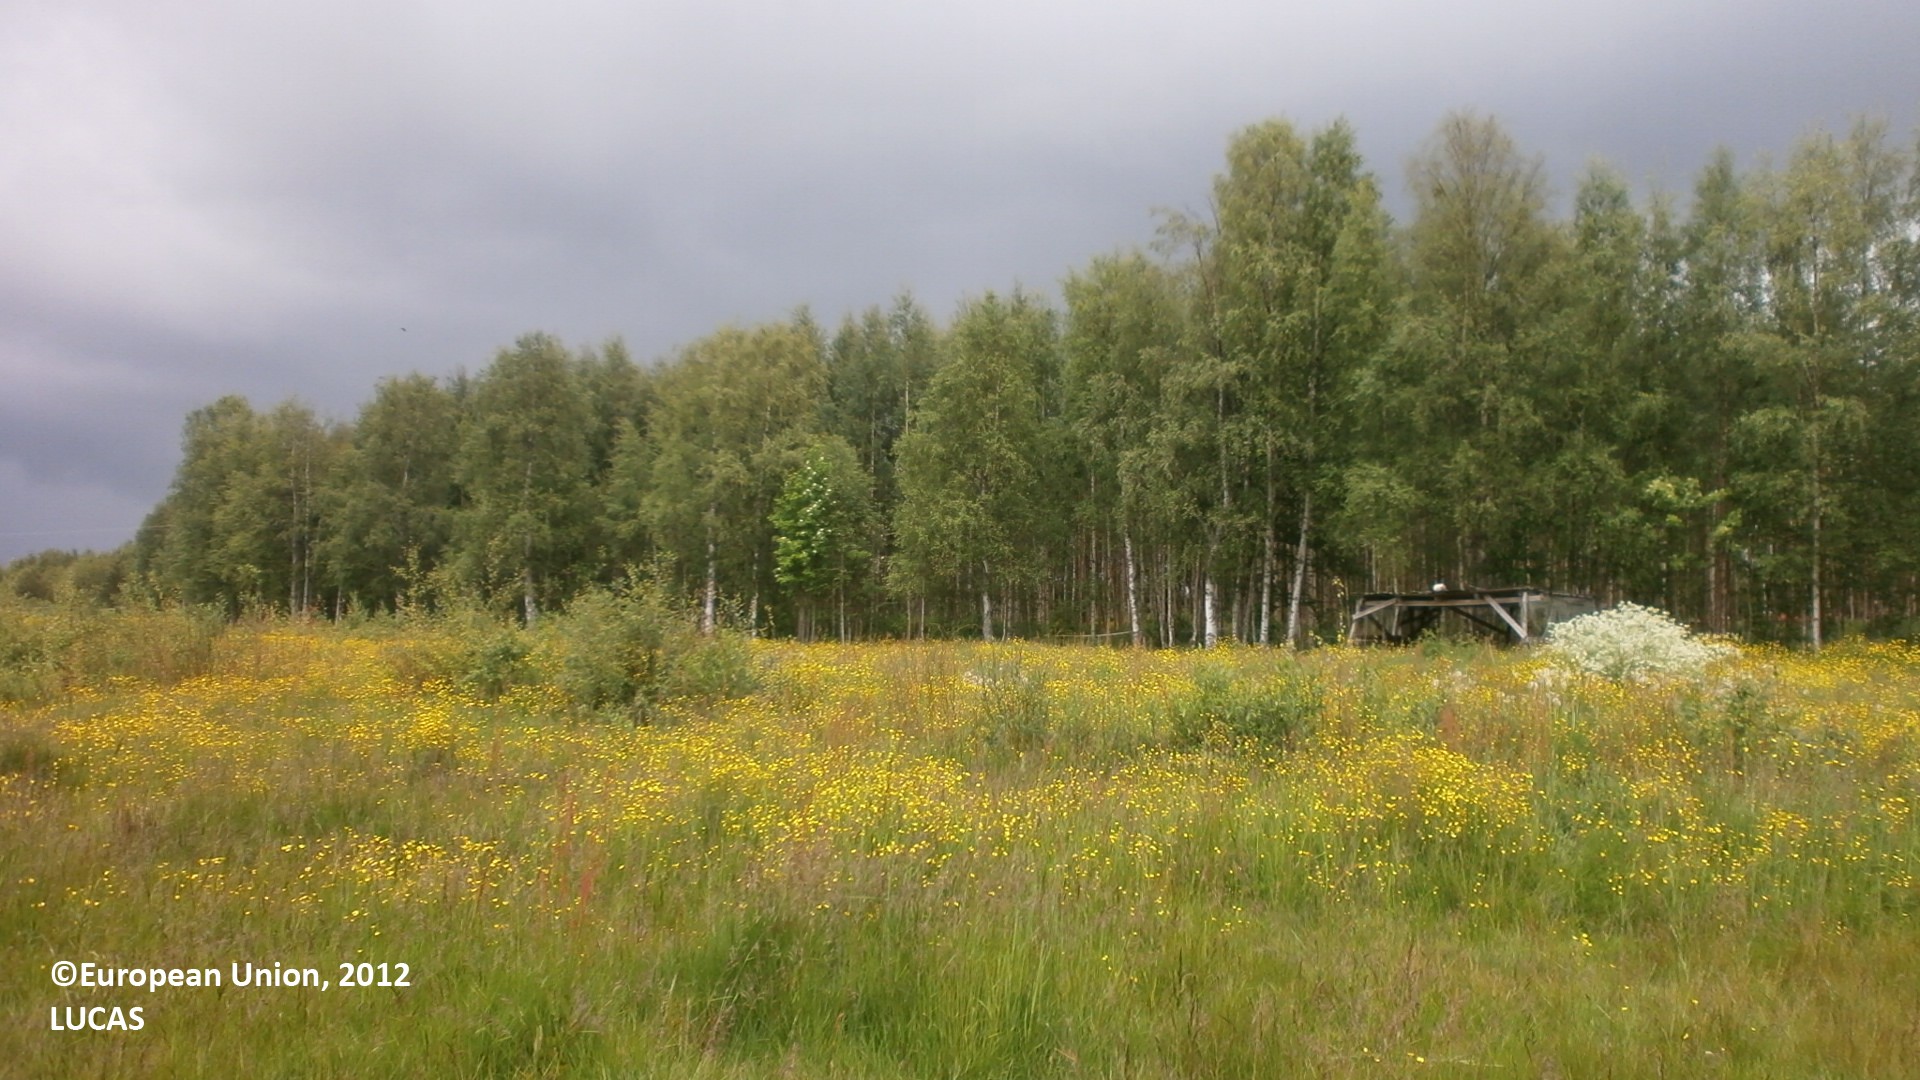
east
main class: Grassland
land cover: Grassland without tree/shrub cover
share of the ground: > 75 %
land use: Agriculture (excluding fallow land and kitchen gardens)
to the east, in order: Grassland without tree/shrub cover; Ditches and canals; Grassland without tree/shrub cover; Fences; Ditches and canals; Fences; Broadleaved woodland; Spontaneously vegetated surfaces; Broadleaved woodland; Pine dominated coniferous woodland; Broadleaved woodland; Spontaneously vegetated surfaces; Broadleaved woodland; Spontaneously vegetated surfaces; Fences; Broadleaved woodland; Electric lines; Broadleaved woodland; Temporary grasslands
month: June
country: FI
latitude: 64.8133
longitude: 25.3082
